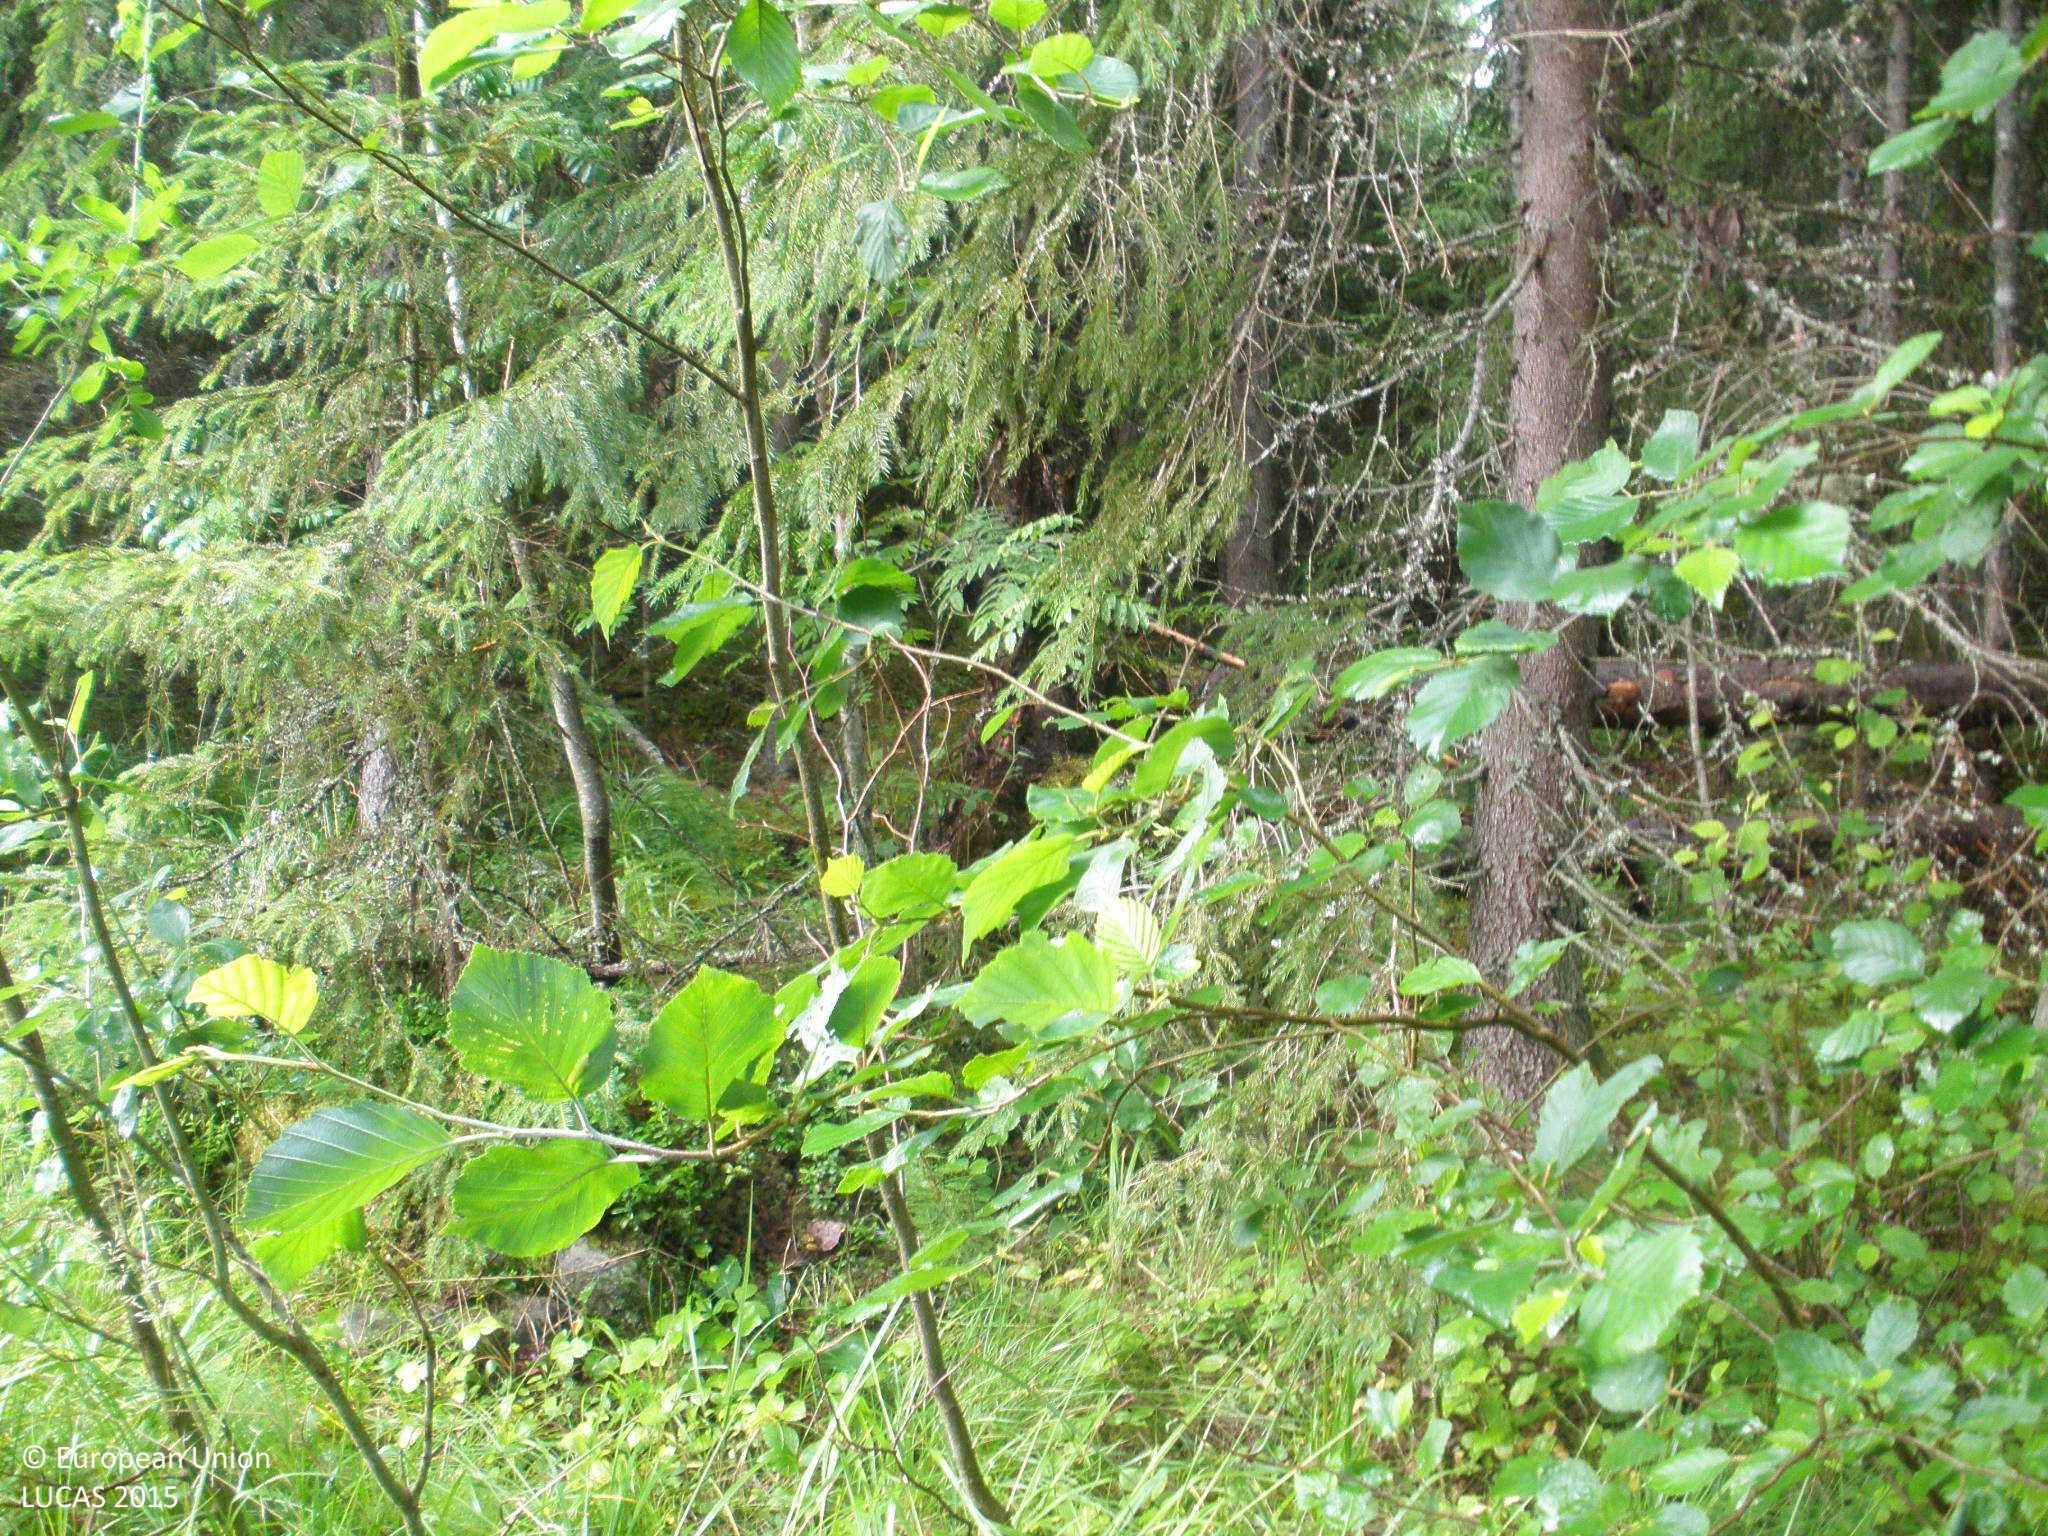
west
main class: Woodland
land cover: Spruce dominated mixed woodland
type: boreal forest
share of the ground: > 75 %
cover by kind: coniferous forest trees 60 %, broadleaved forest trees 25 %, herbaceous plants 10 %, lichens and mosses 5 %
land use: Forestry
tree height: > 5 m
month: July
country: FI
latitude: 61.3323
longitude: 24.8892
